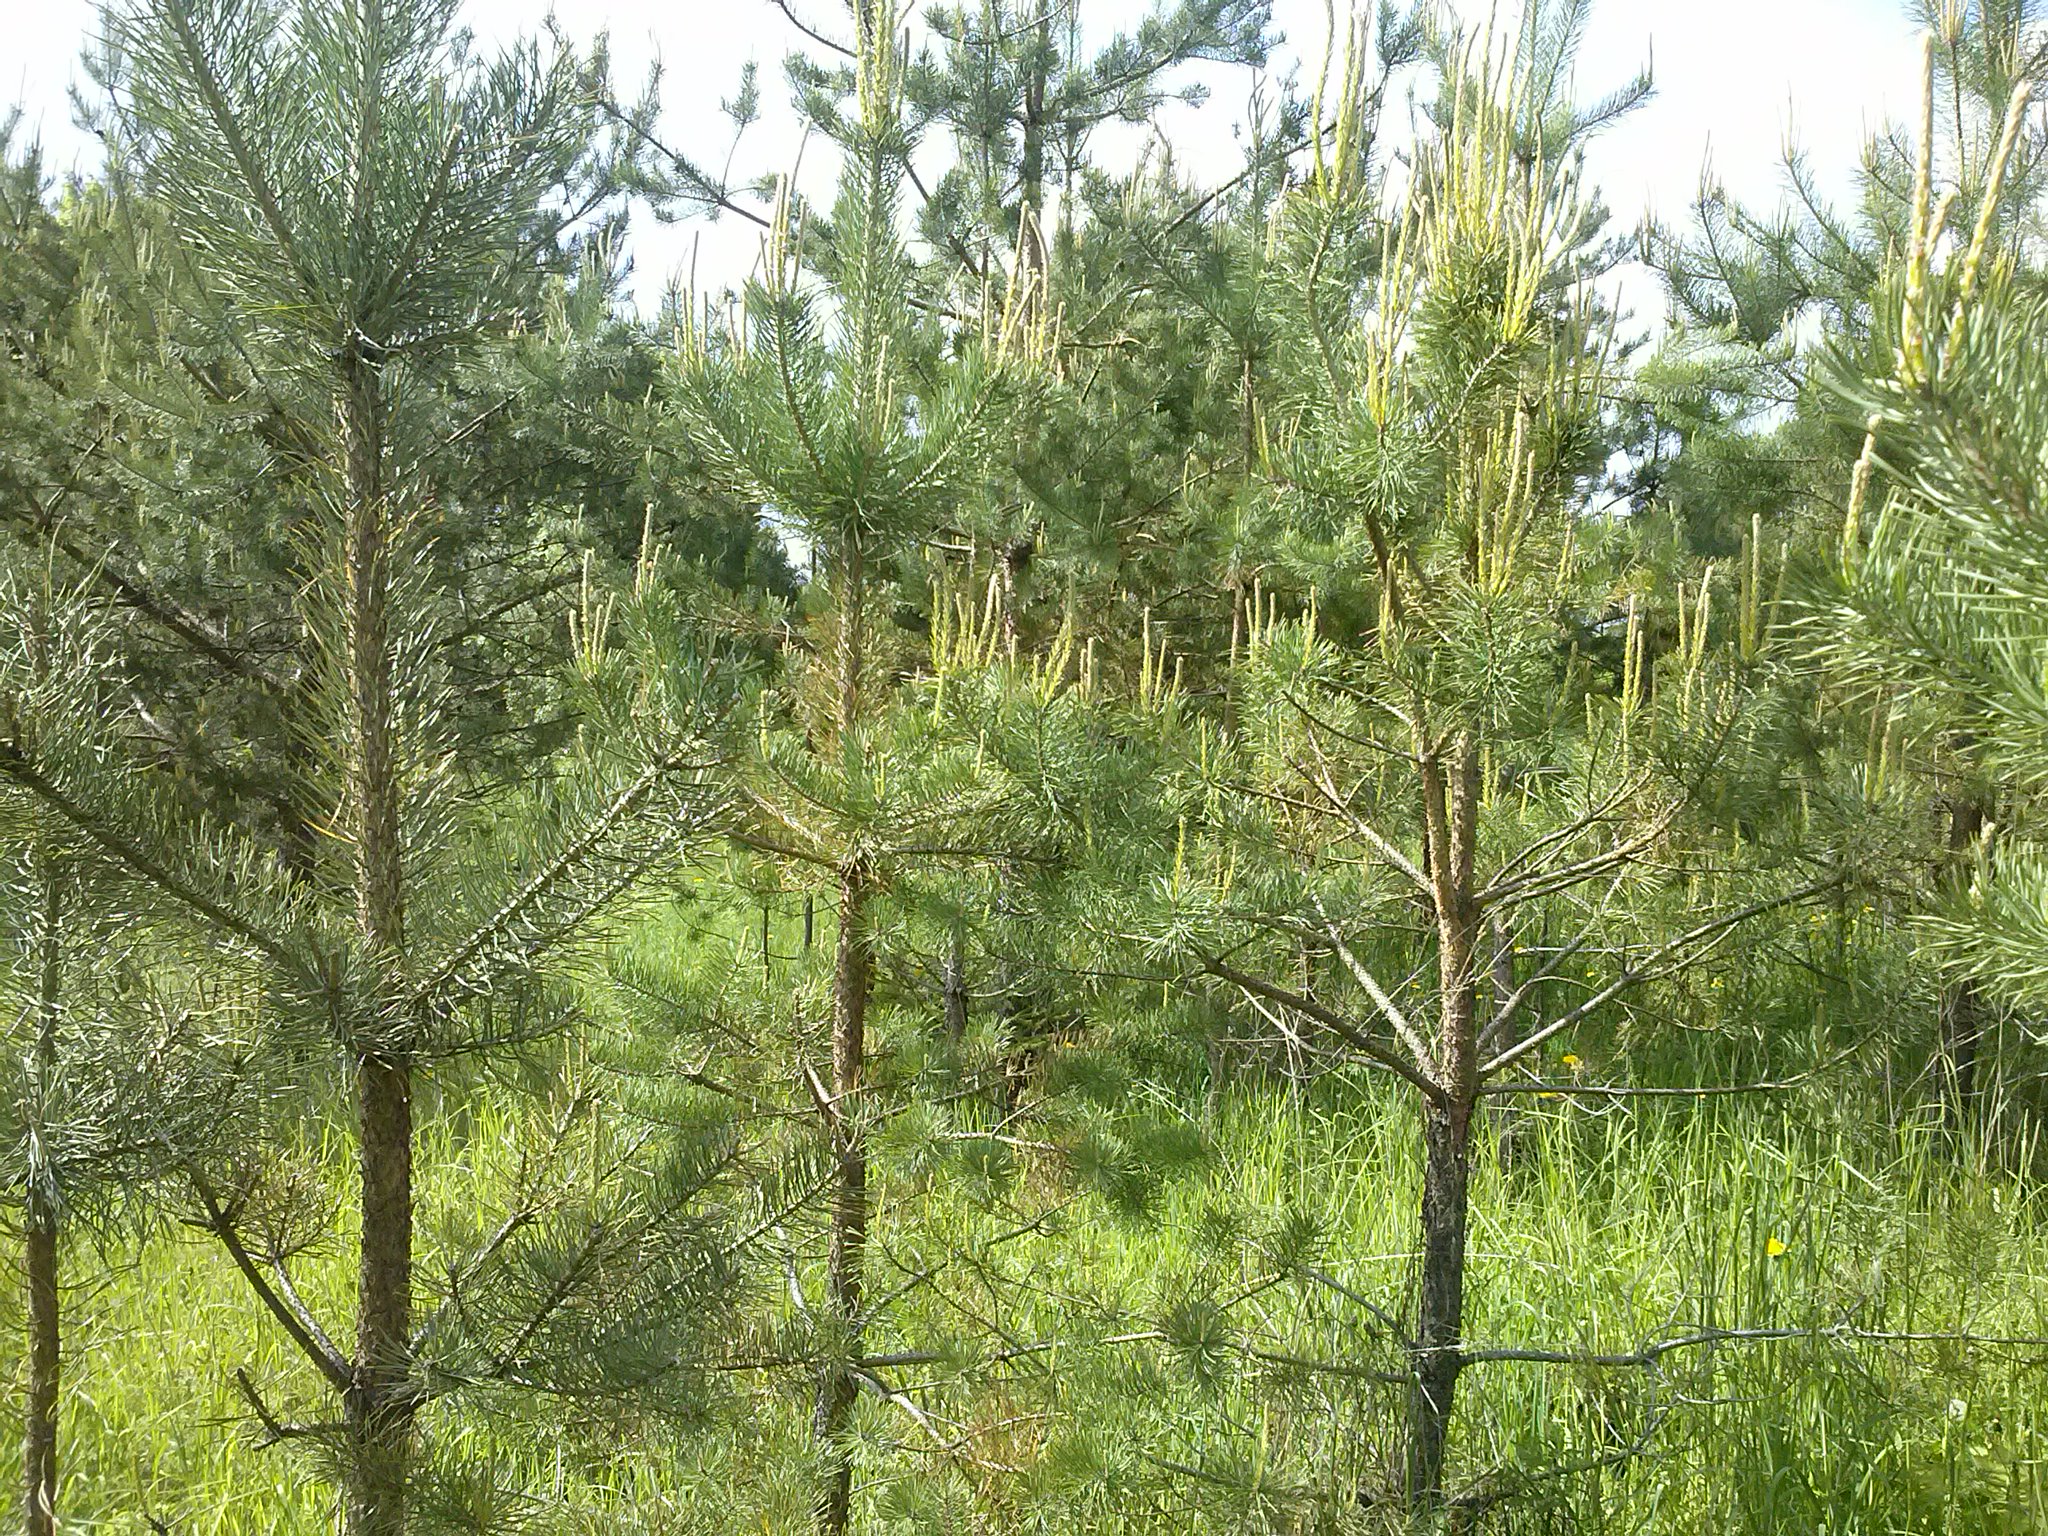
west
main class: Woodland
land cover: Pine dominated mixed woodland
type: hemiboreal forest and nemoral coniferous forest and mixed broadleaved-coniferous forest
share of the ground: > 75 %
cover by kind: coniferous forest trees 55 %, broadleaved forest trees 45 %
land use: Forestry
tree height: > 5 m
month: May
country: LV
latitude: 56.2528
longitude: 27.8333
